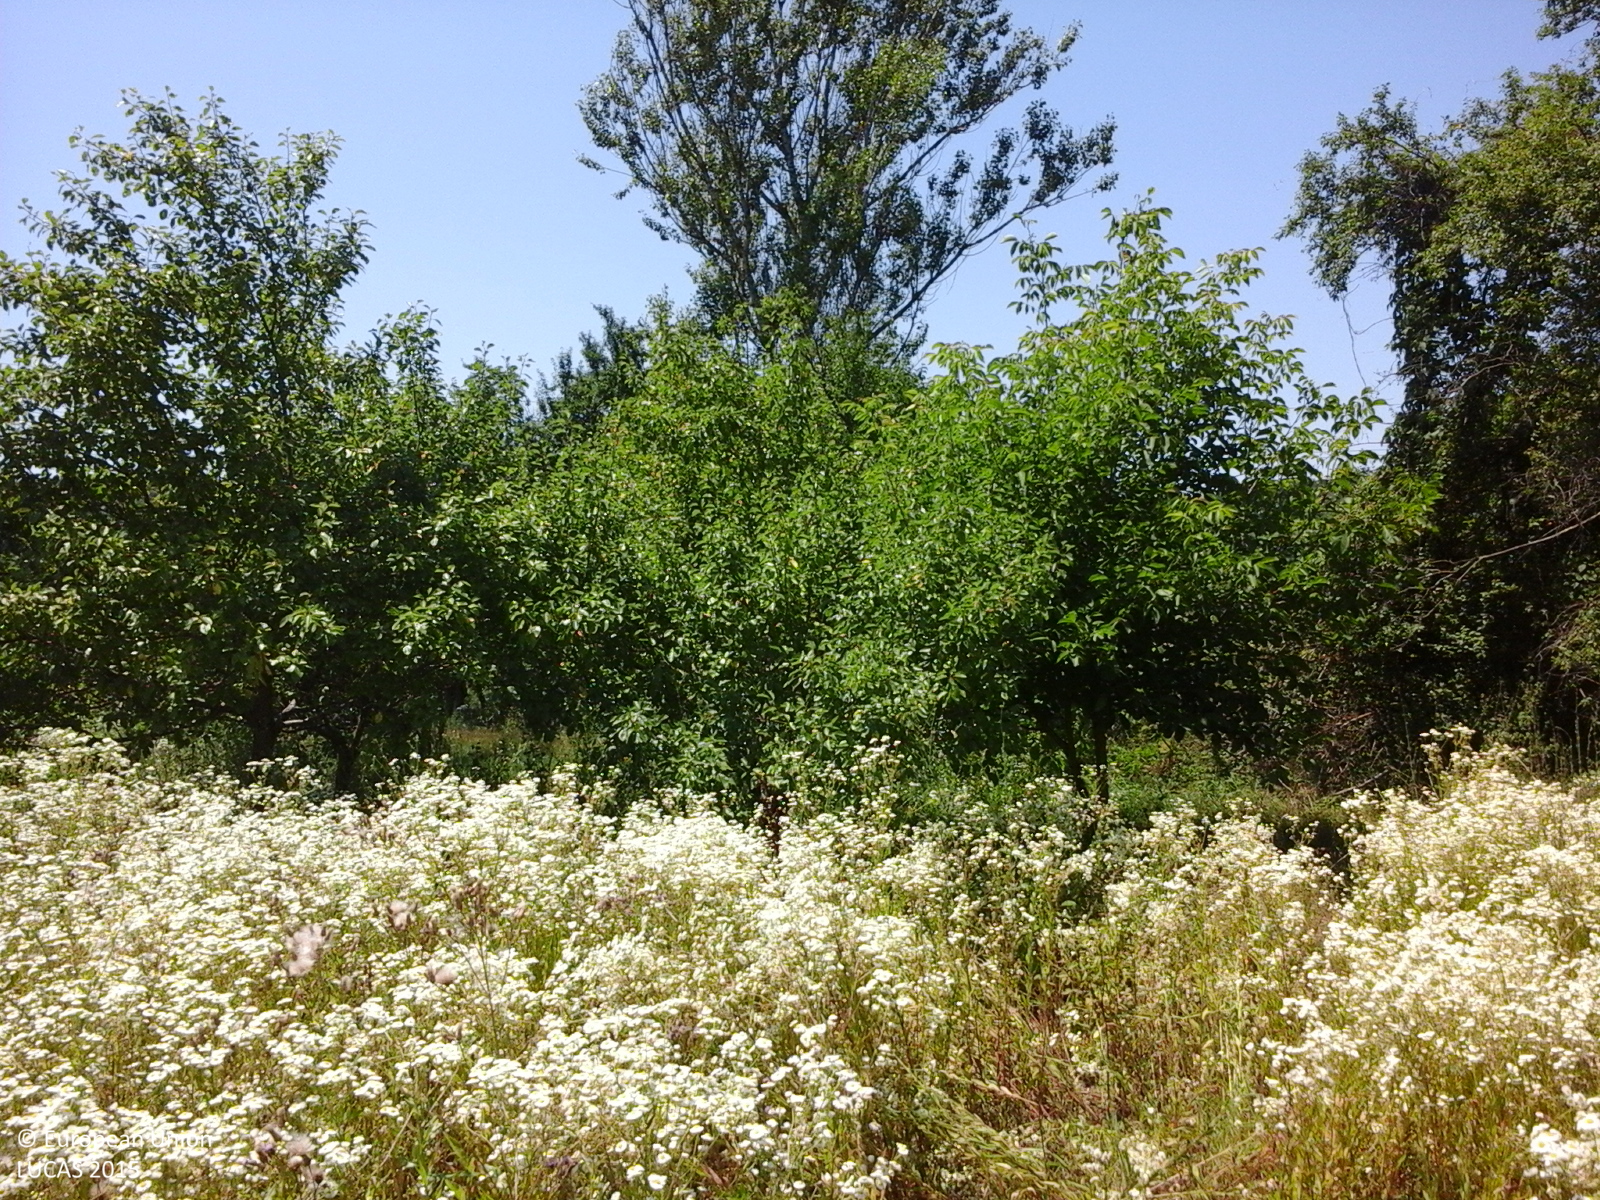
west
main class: Grassland
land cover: Spontaneously vegetated surfaces
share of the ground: > 75 %
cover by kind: herbaceous plants 100 %
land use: Agriculture (excluding fallow land and kitchen gardens)
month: July
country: RO
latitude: 44.6419
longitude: 24.3796
